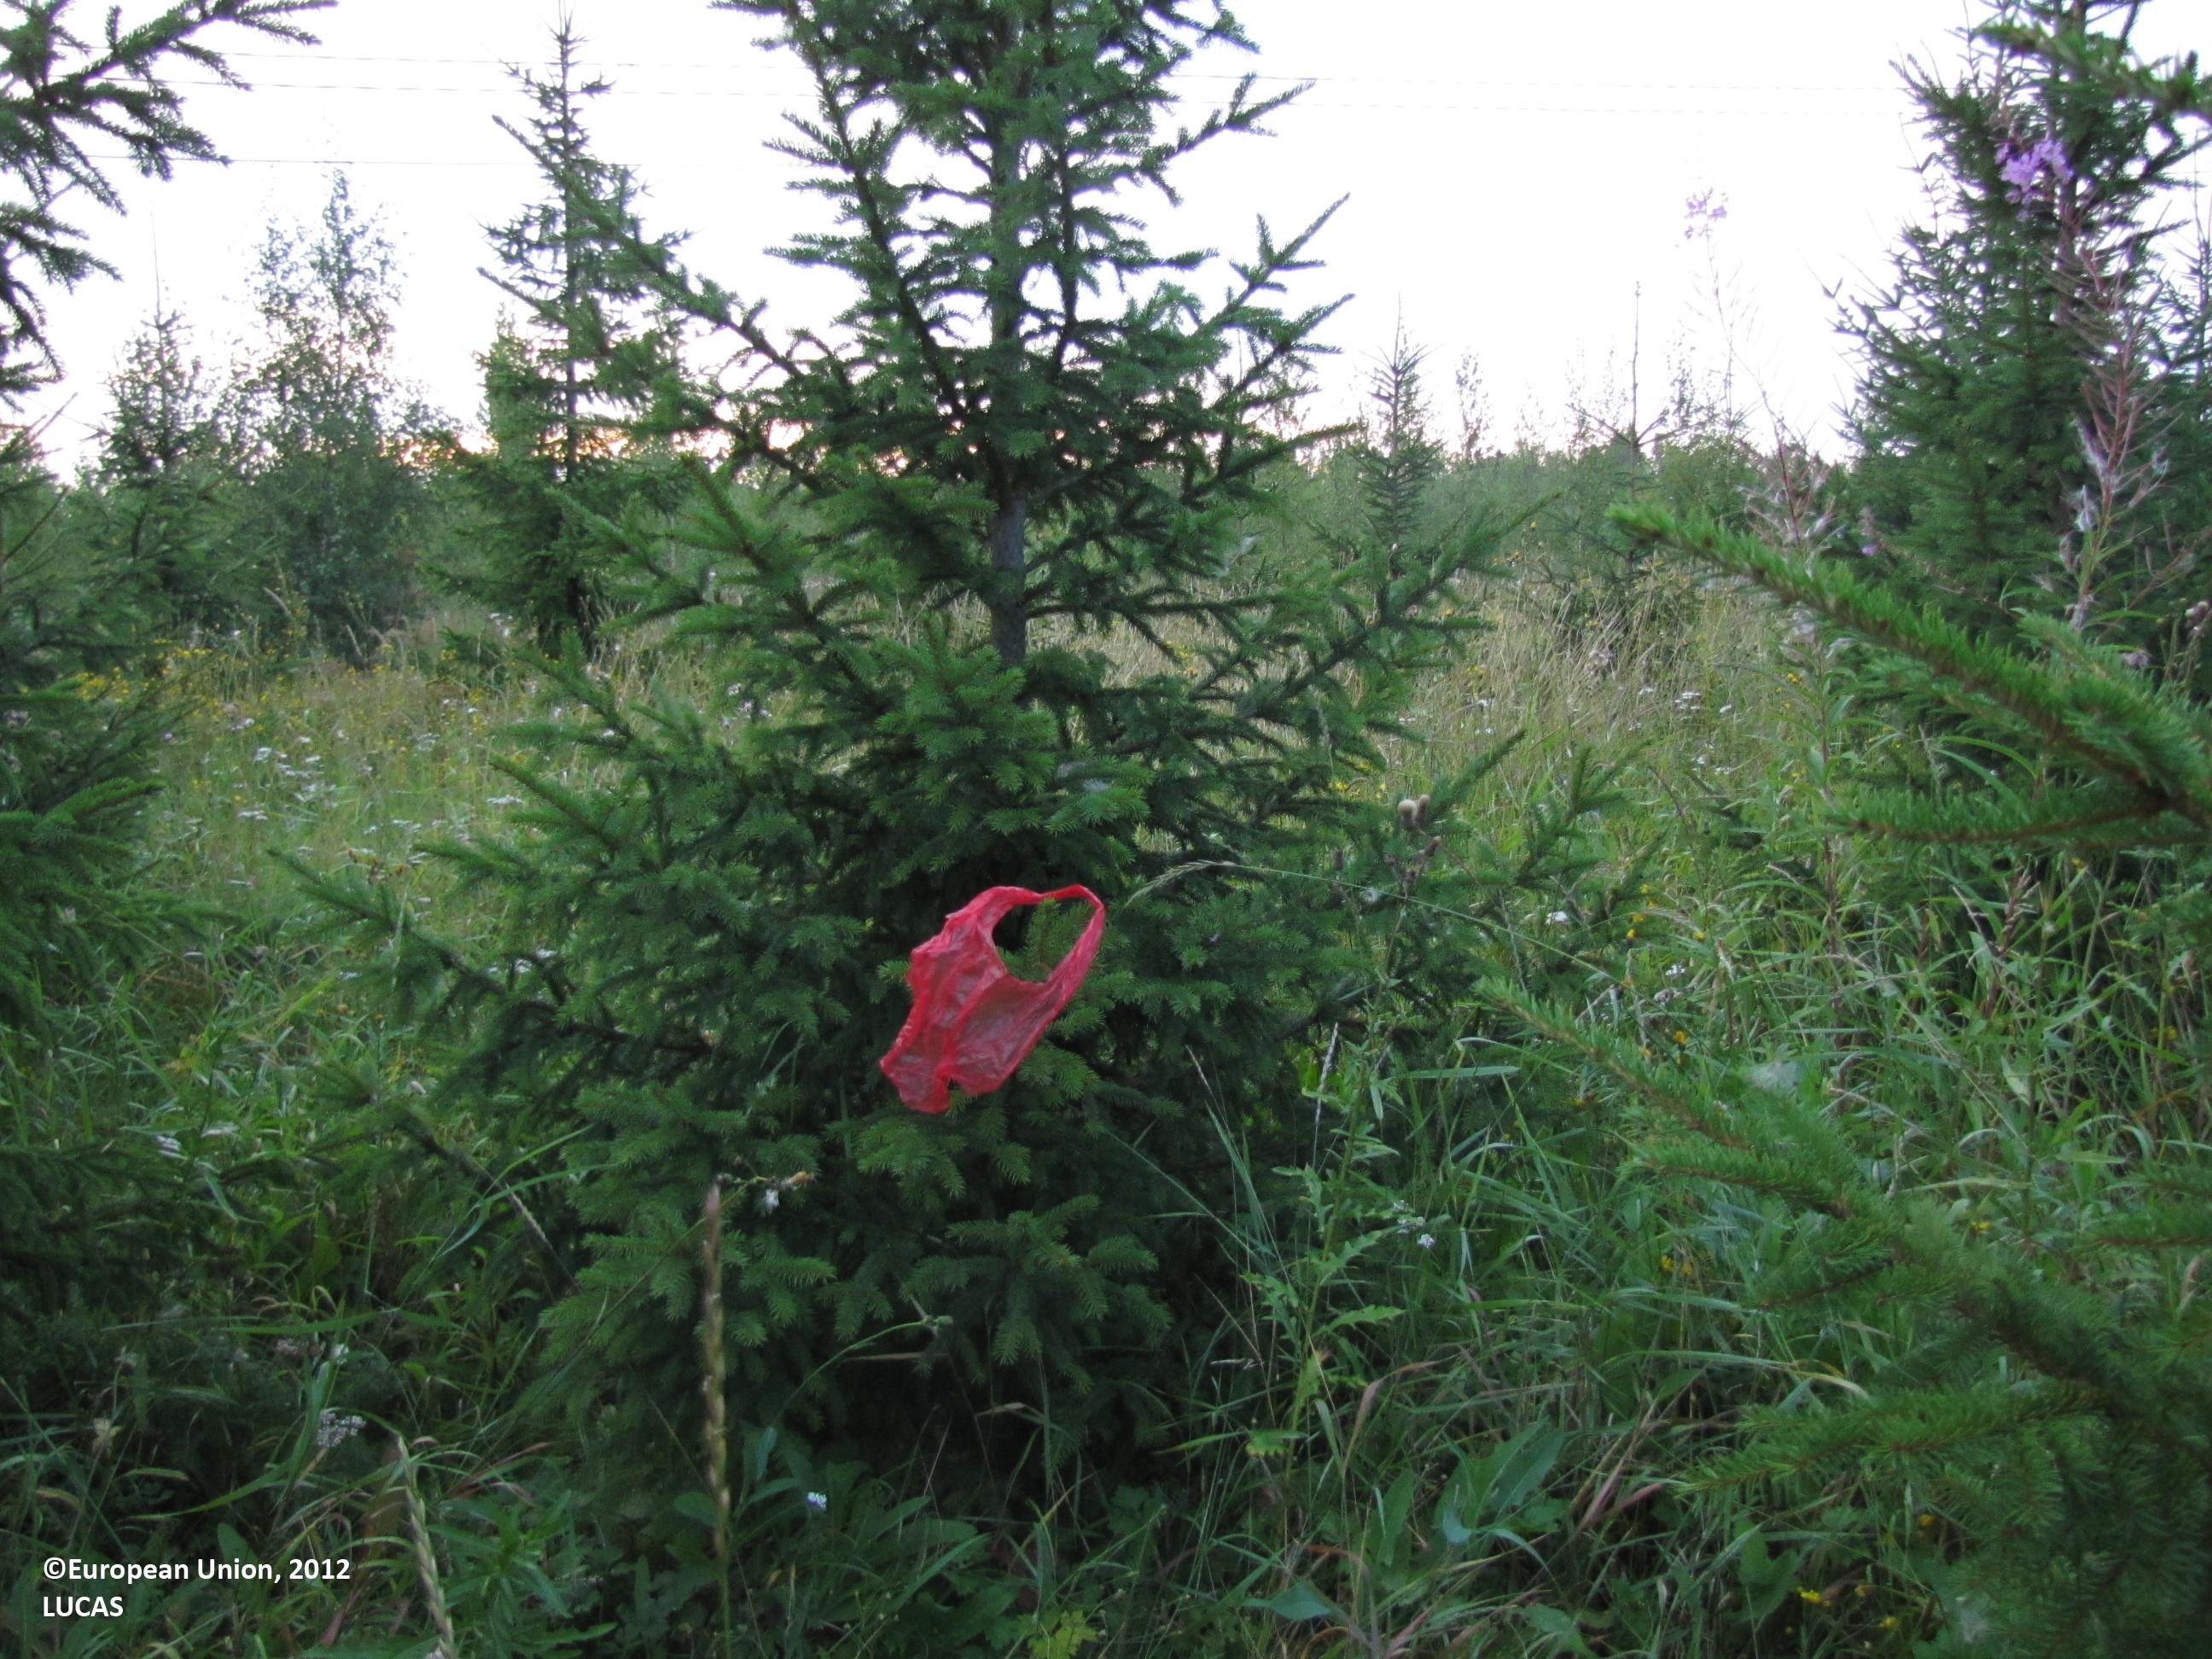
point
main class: Woodland
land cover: Spruce dominated coniferous woodland
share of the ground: 50 - 75 %
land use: Forestry
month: August
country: FI
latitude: 61.4412
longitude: 23.6014
